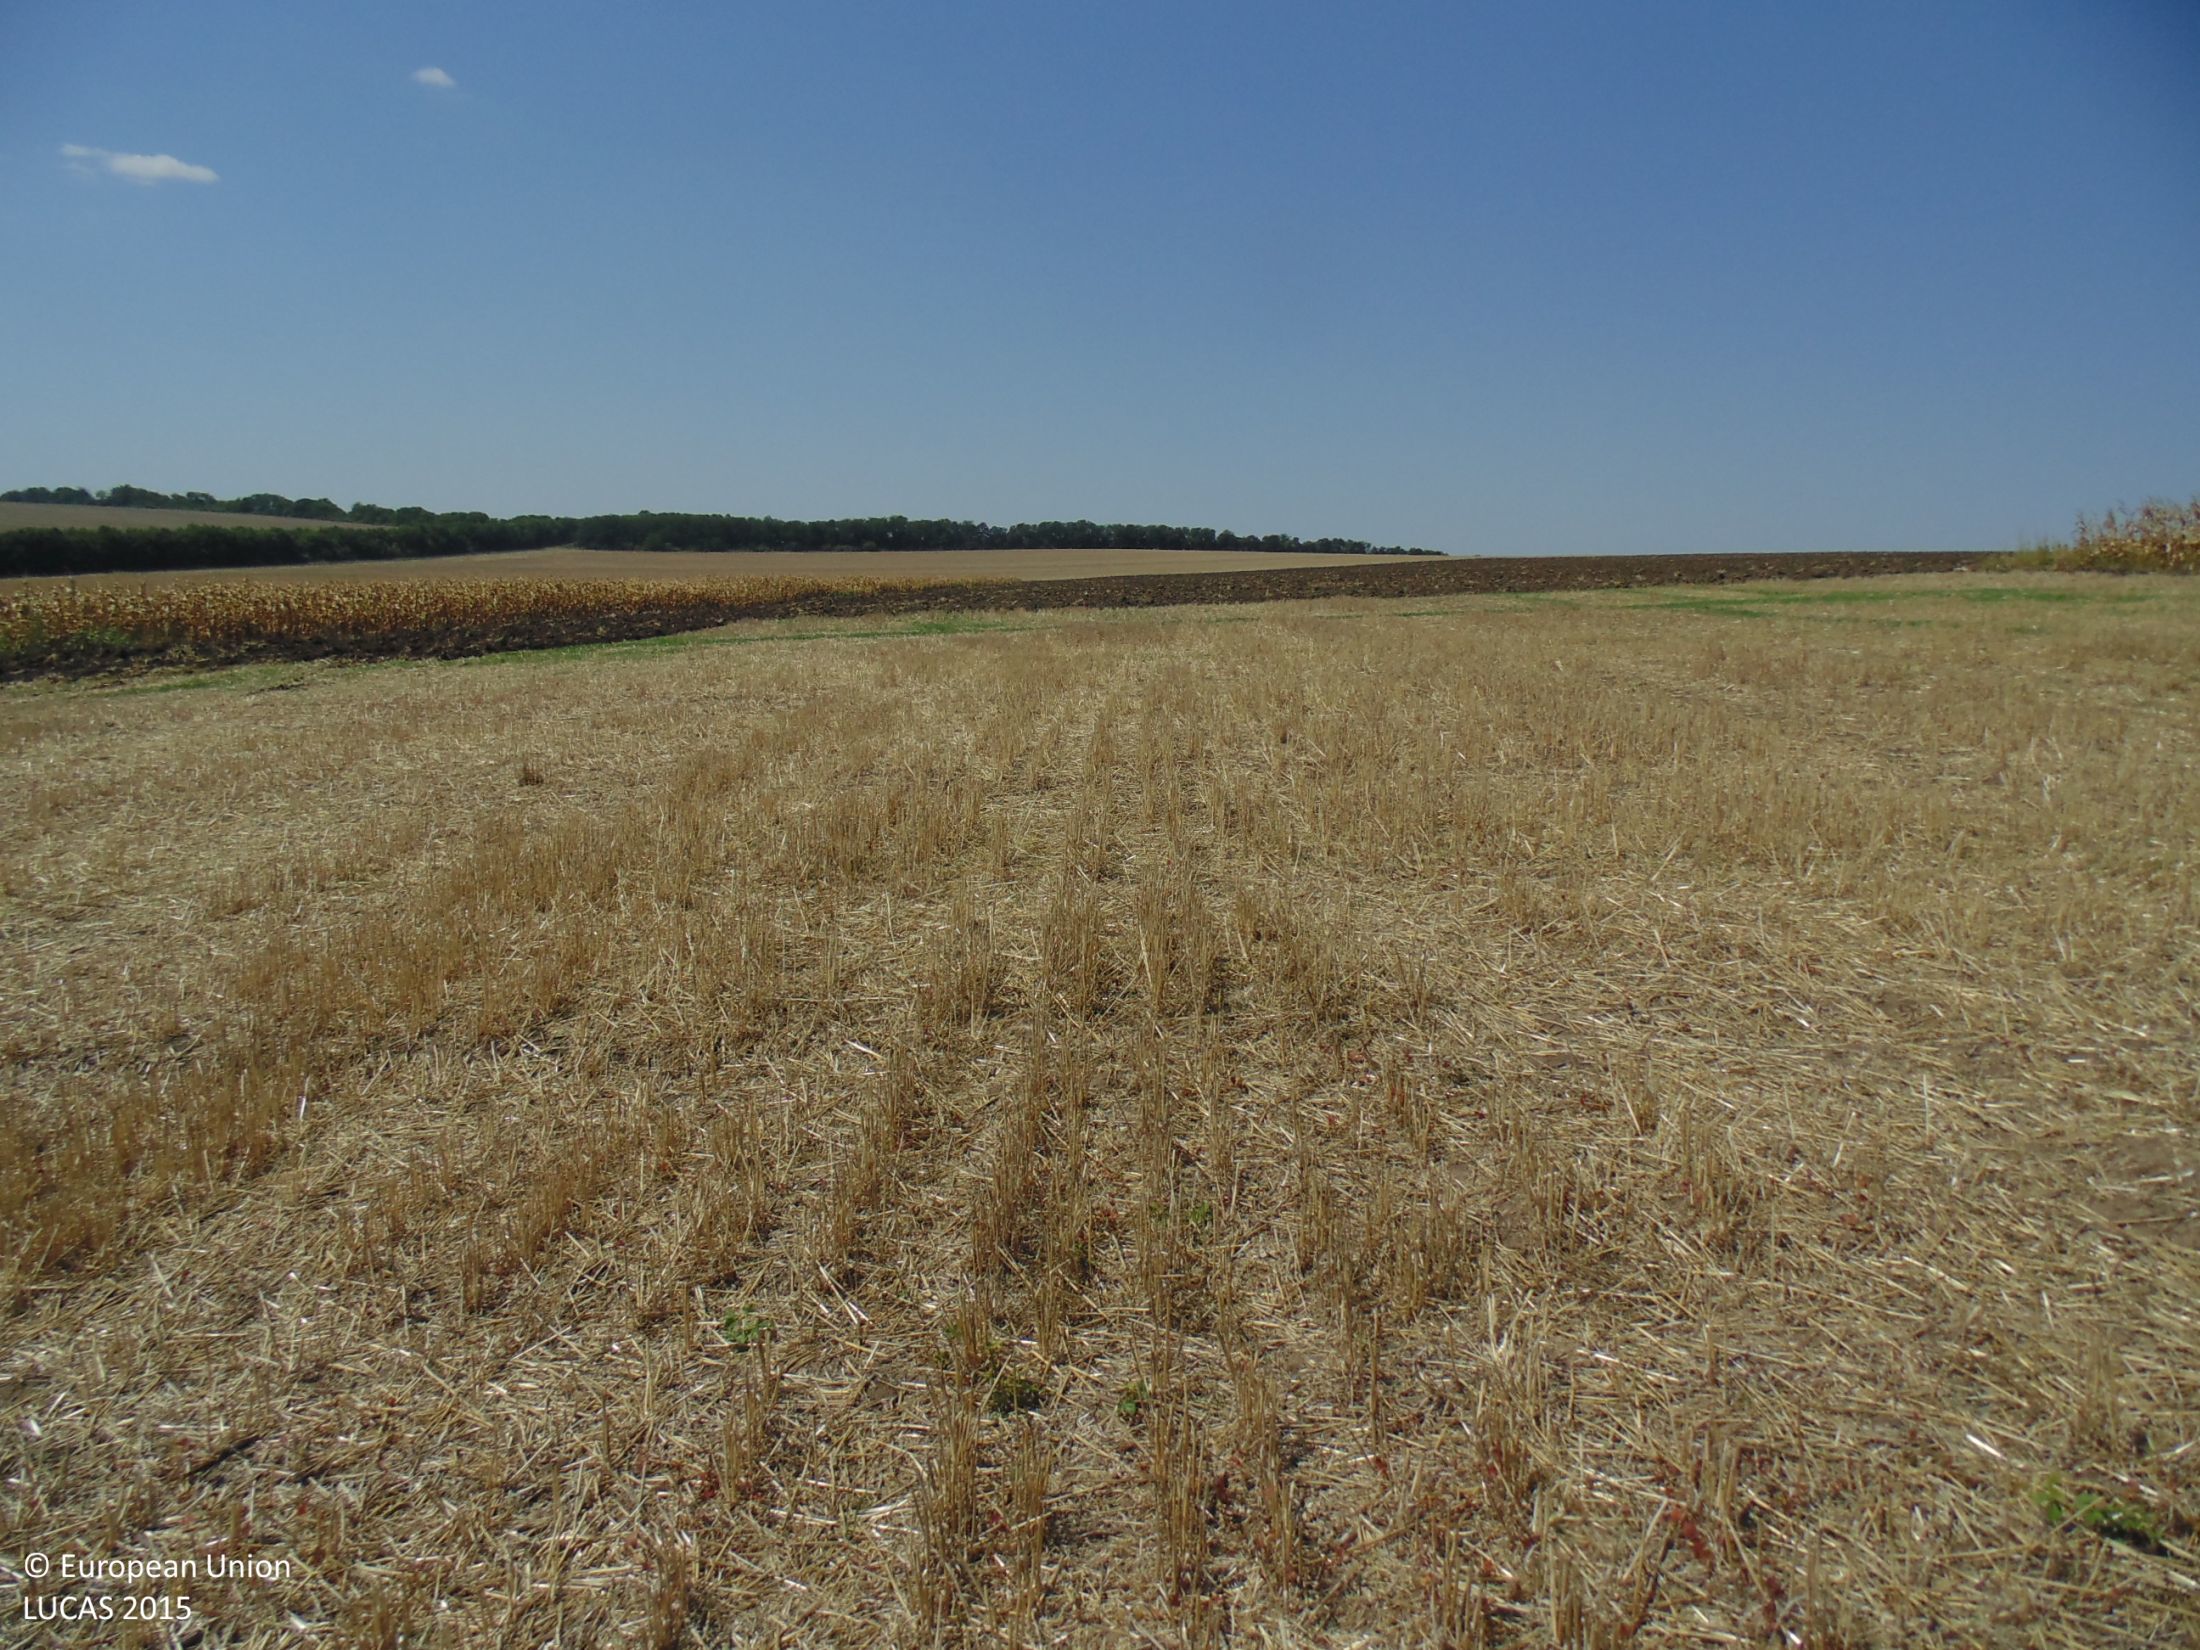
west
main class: Cropland
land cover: Common wheat
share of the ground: 25 - 50 %
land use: Agriculture (excluding fallow land and kitchen gardens)
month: August
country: BG
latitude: 43.6672
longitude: 27.4572
